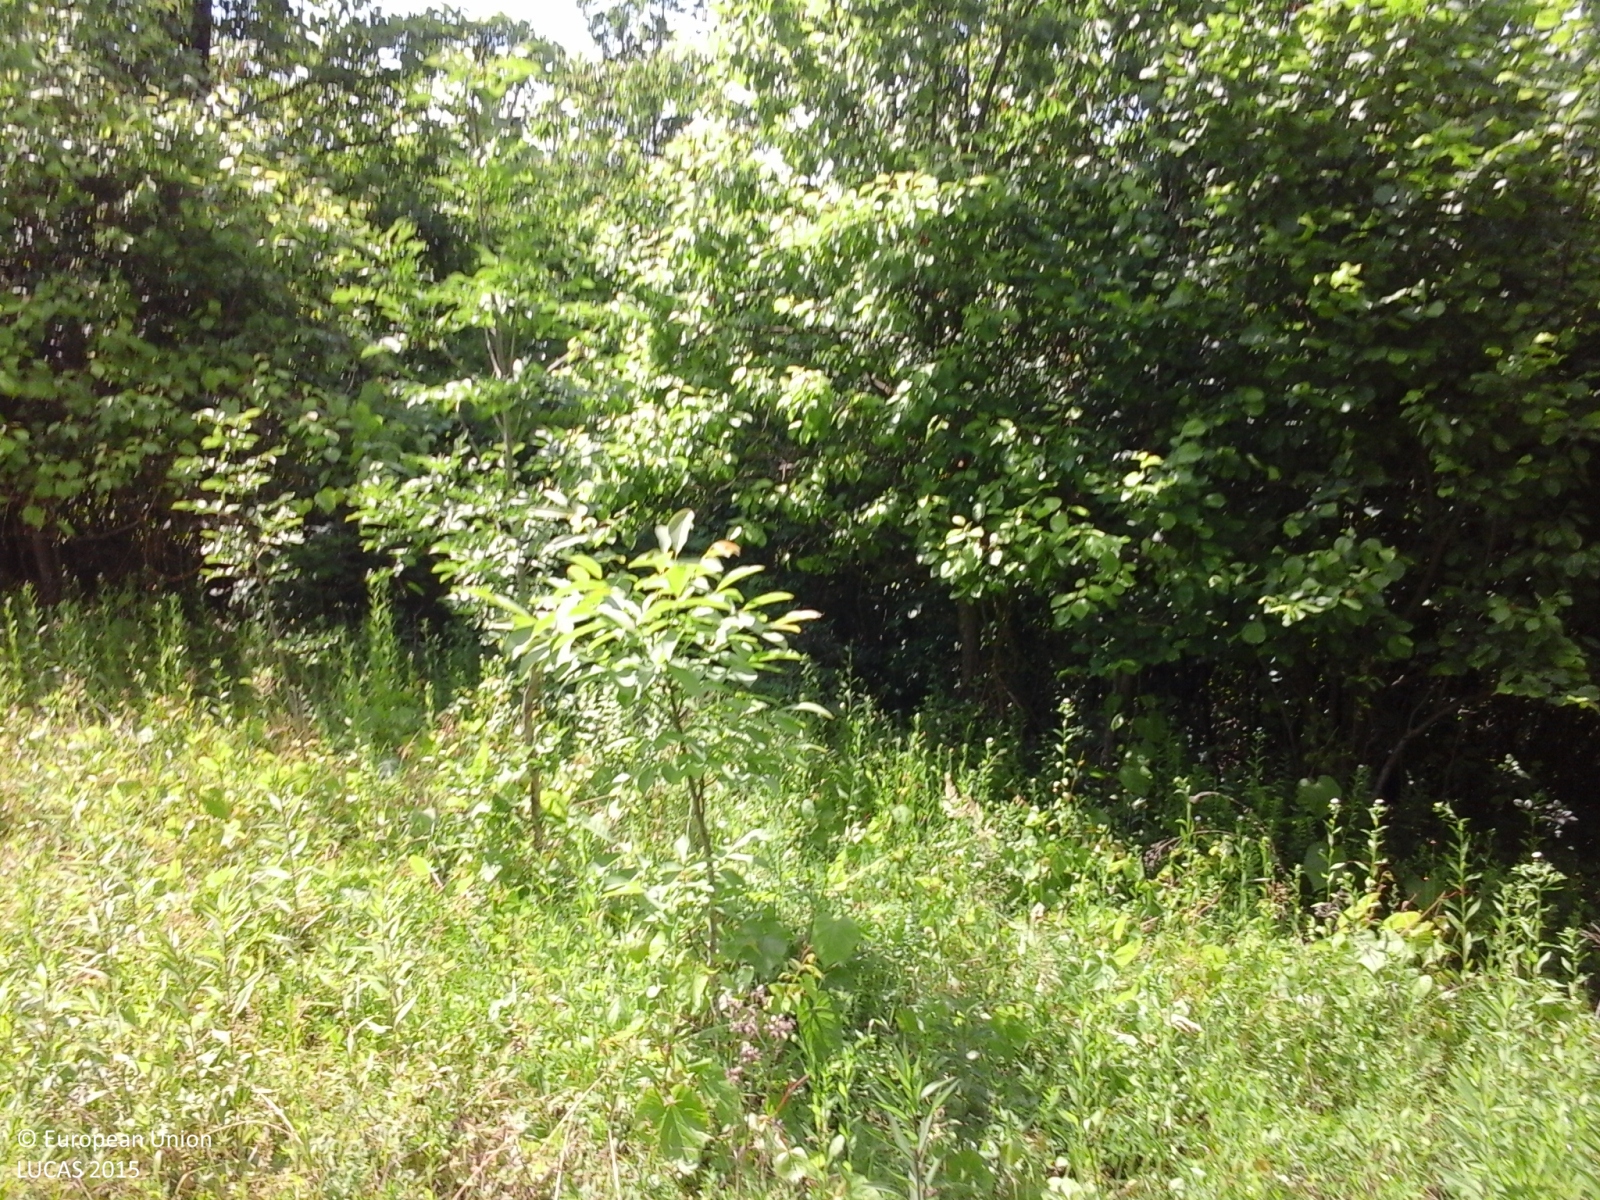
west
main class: Grassland
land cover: Grassland with sparse tree/shrub cover
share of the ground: > 75 %
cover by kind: herbaceous plants 85 %, shrubs 10 %, broadleaved forest trees 5 %
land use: Agriculture (excluding fallow land and kitchen gardens)
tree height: > 5 m
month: May
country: IT
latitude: 44.6648
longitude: 8.5274
